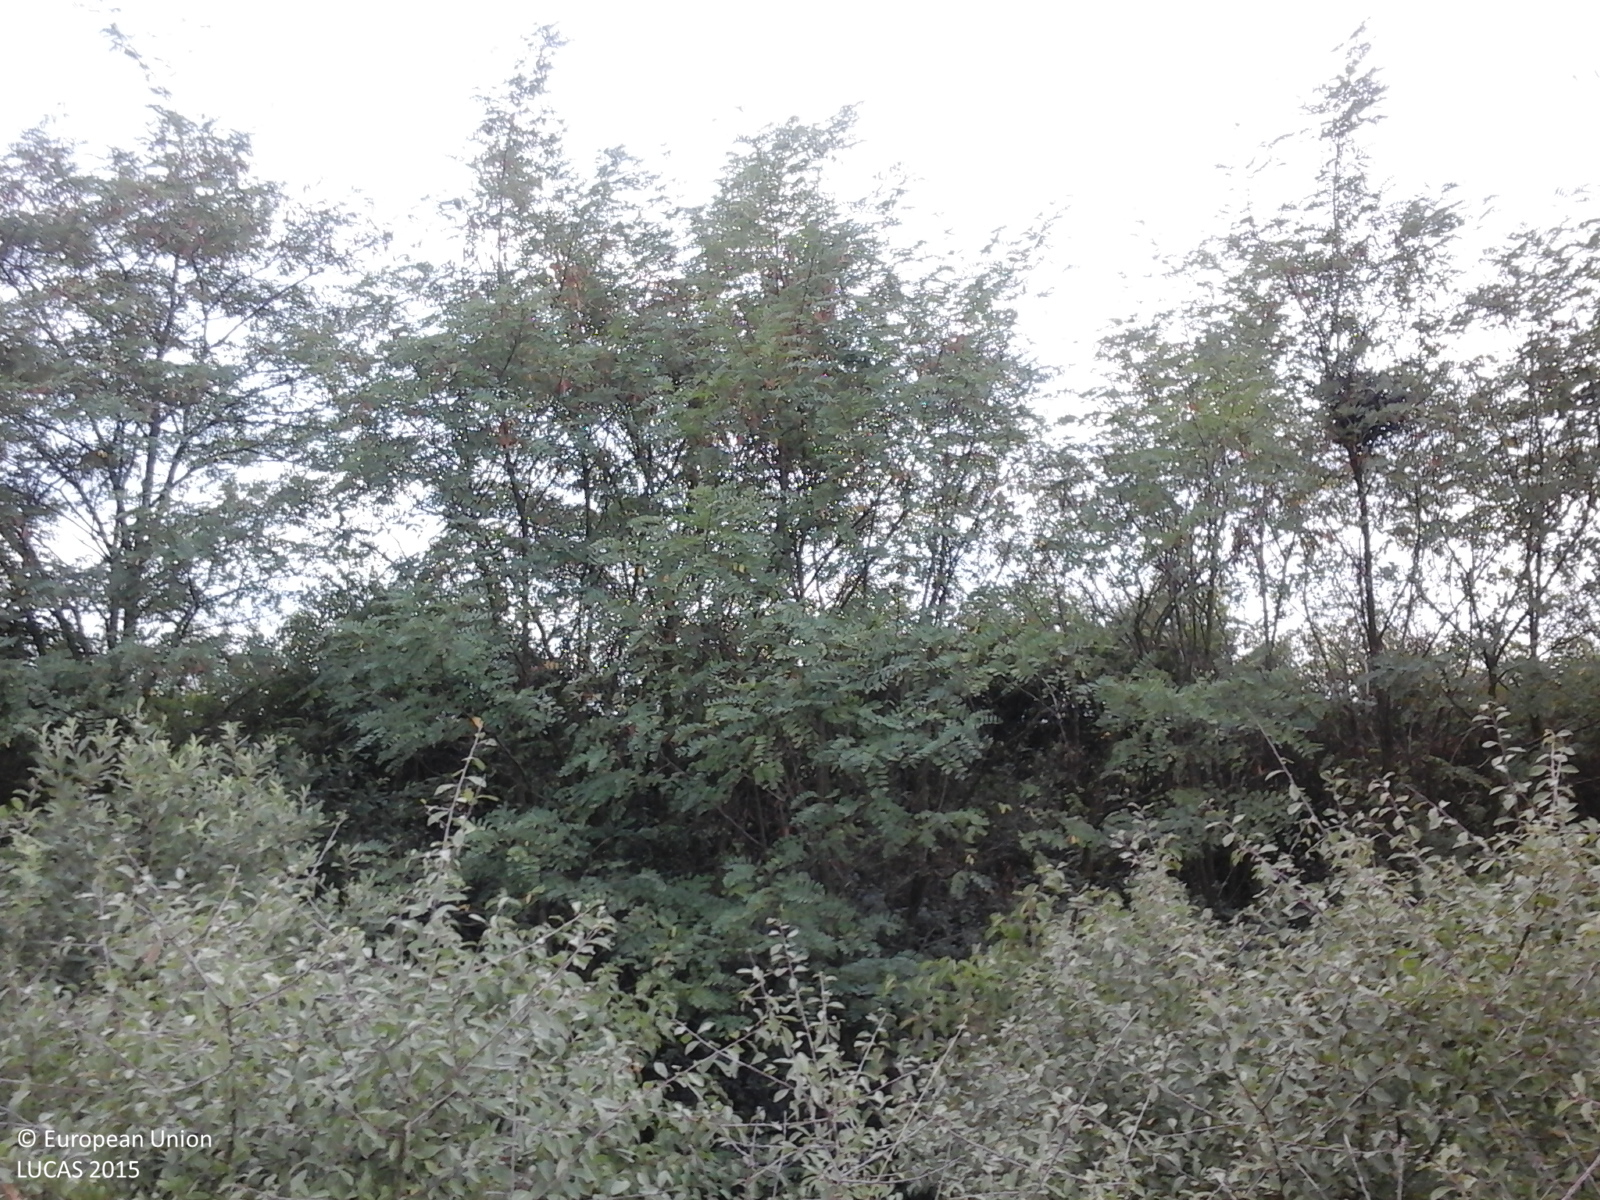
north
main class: Woodland
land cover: Broadleaved woodland
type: exotic forest
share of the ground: > 75 %
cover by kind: broadleaved forest trees 100 %
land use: Forestry
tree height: > 5 m
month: August
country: RO
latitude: 45.6472
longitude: 21.4133
